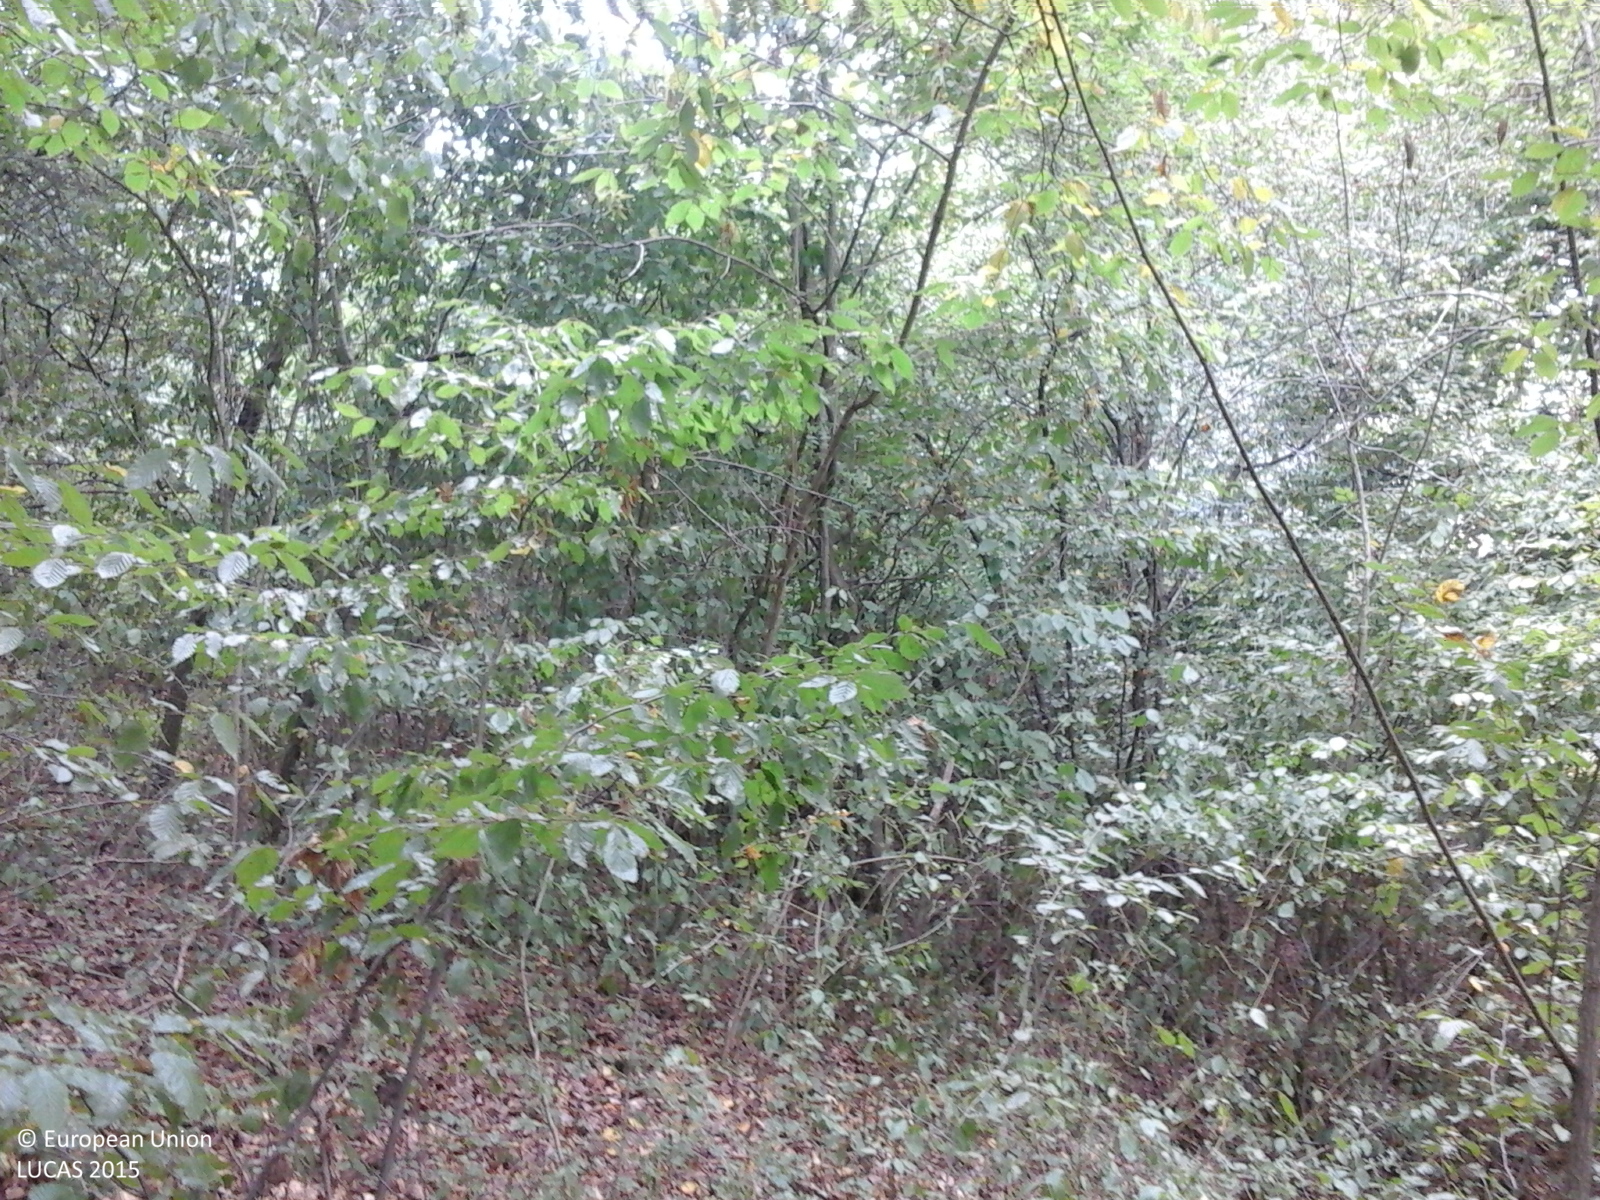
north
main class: Woodland
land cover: Broadleaved woodland
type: mesophytic deciduous forest
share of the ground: > 75 %
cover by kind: broadleaved forest trees 90 %, shrubs 5 %, herbaceous plants 5 %
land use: Forestry
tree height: > 5 m
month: September
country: RO
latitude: 47.5222
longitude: 22.8521
